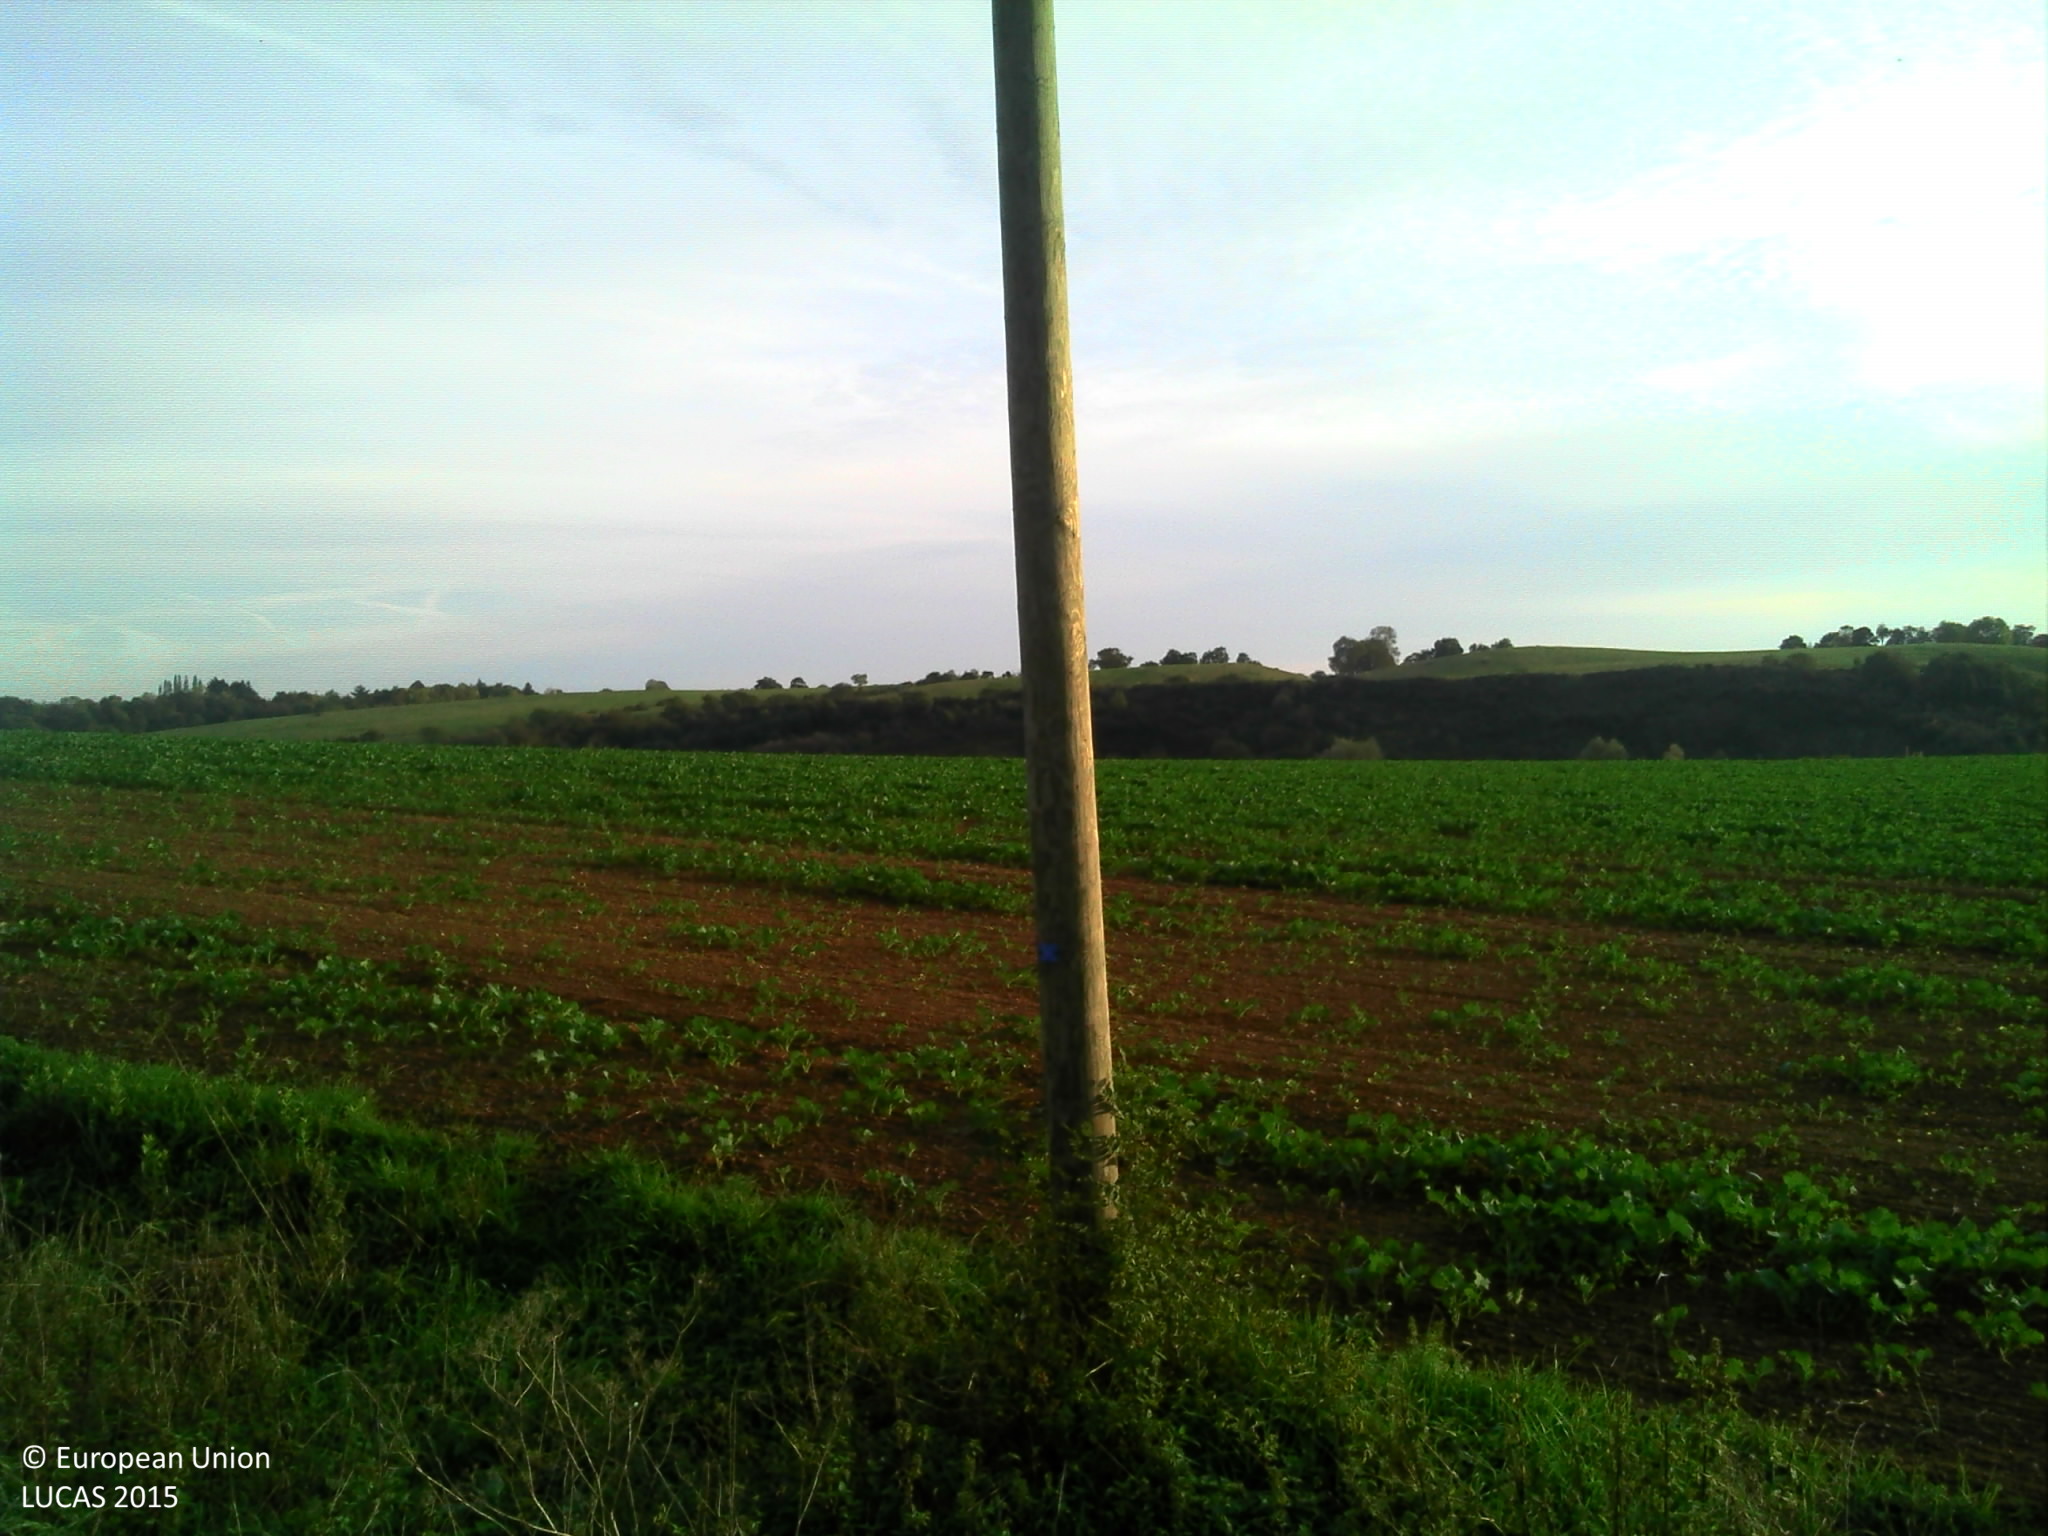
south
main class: Cropland
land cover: Maize
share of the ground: > 75 %
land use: Agriculture (excluding fallow land and kitchen gardens)
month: October
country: FR
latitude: 47.1033
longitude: -1.2243
